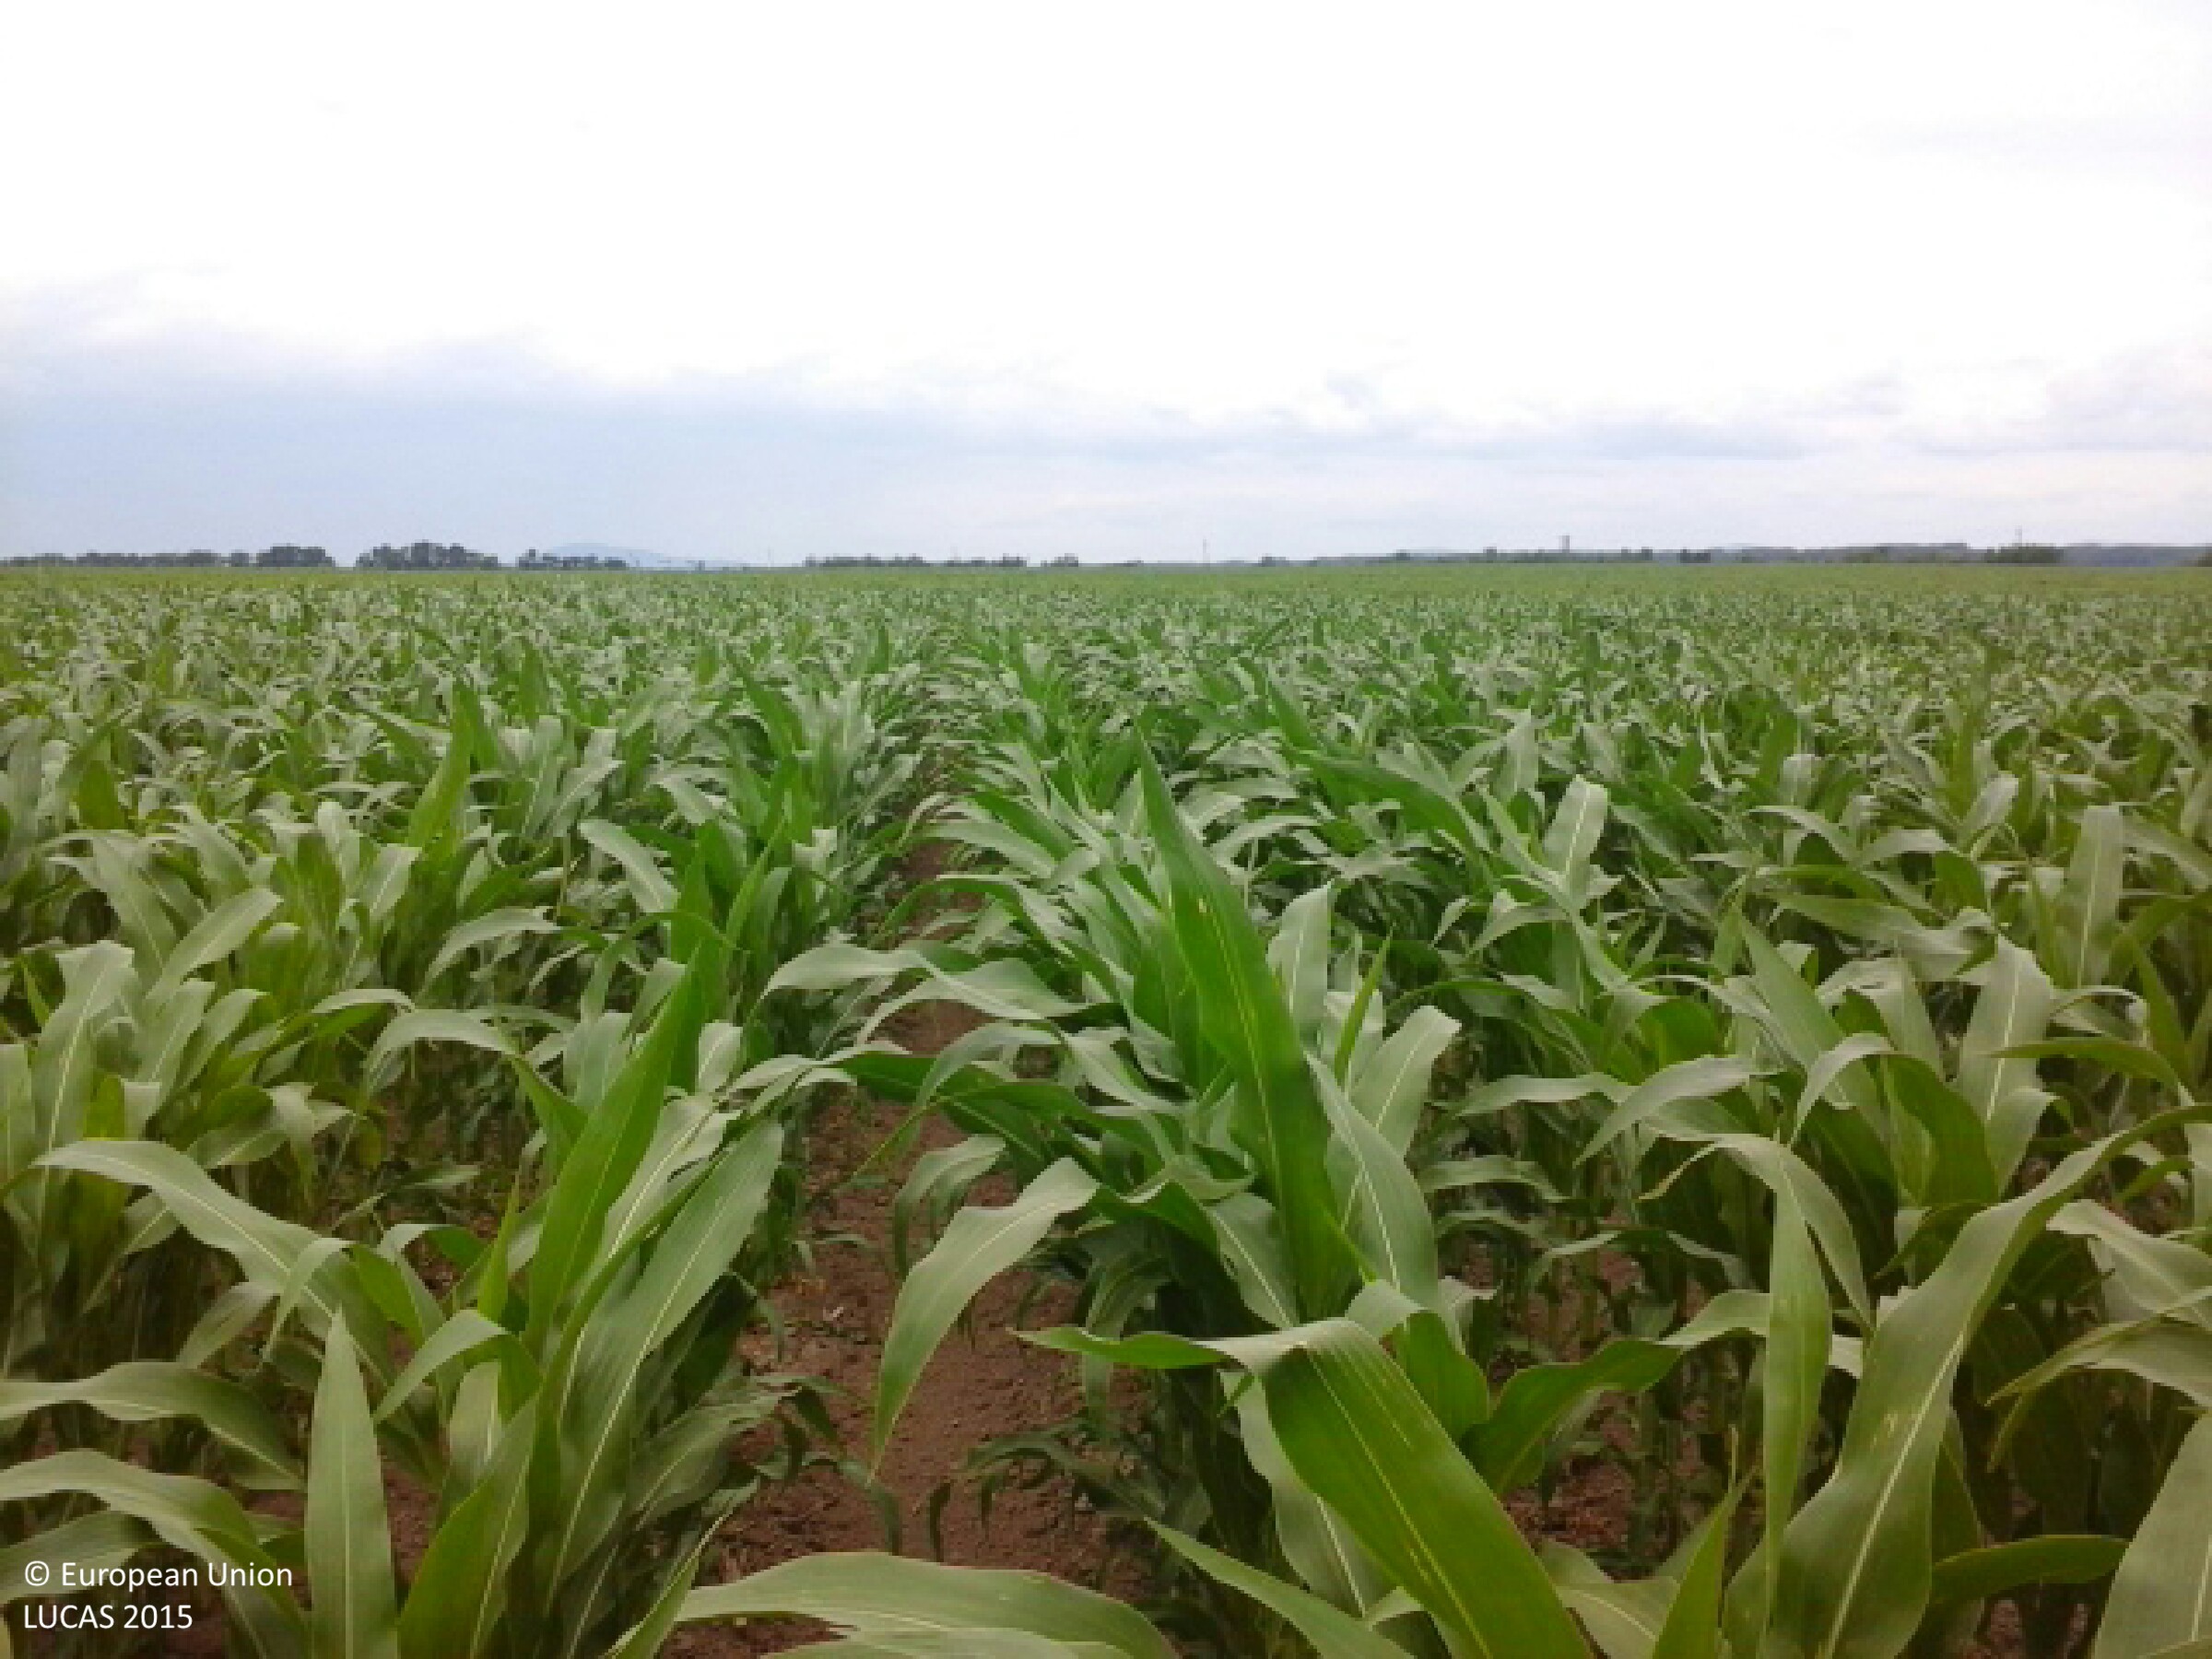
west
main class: Cropland
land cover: Maize
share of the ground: 50 - 75 %
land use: Agriculture (excluding fallow land and kitchen gardens)
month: June
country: HU
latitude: 48.1583
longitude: 21.7315
